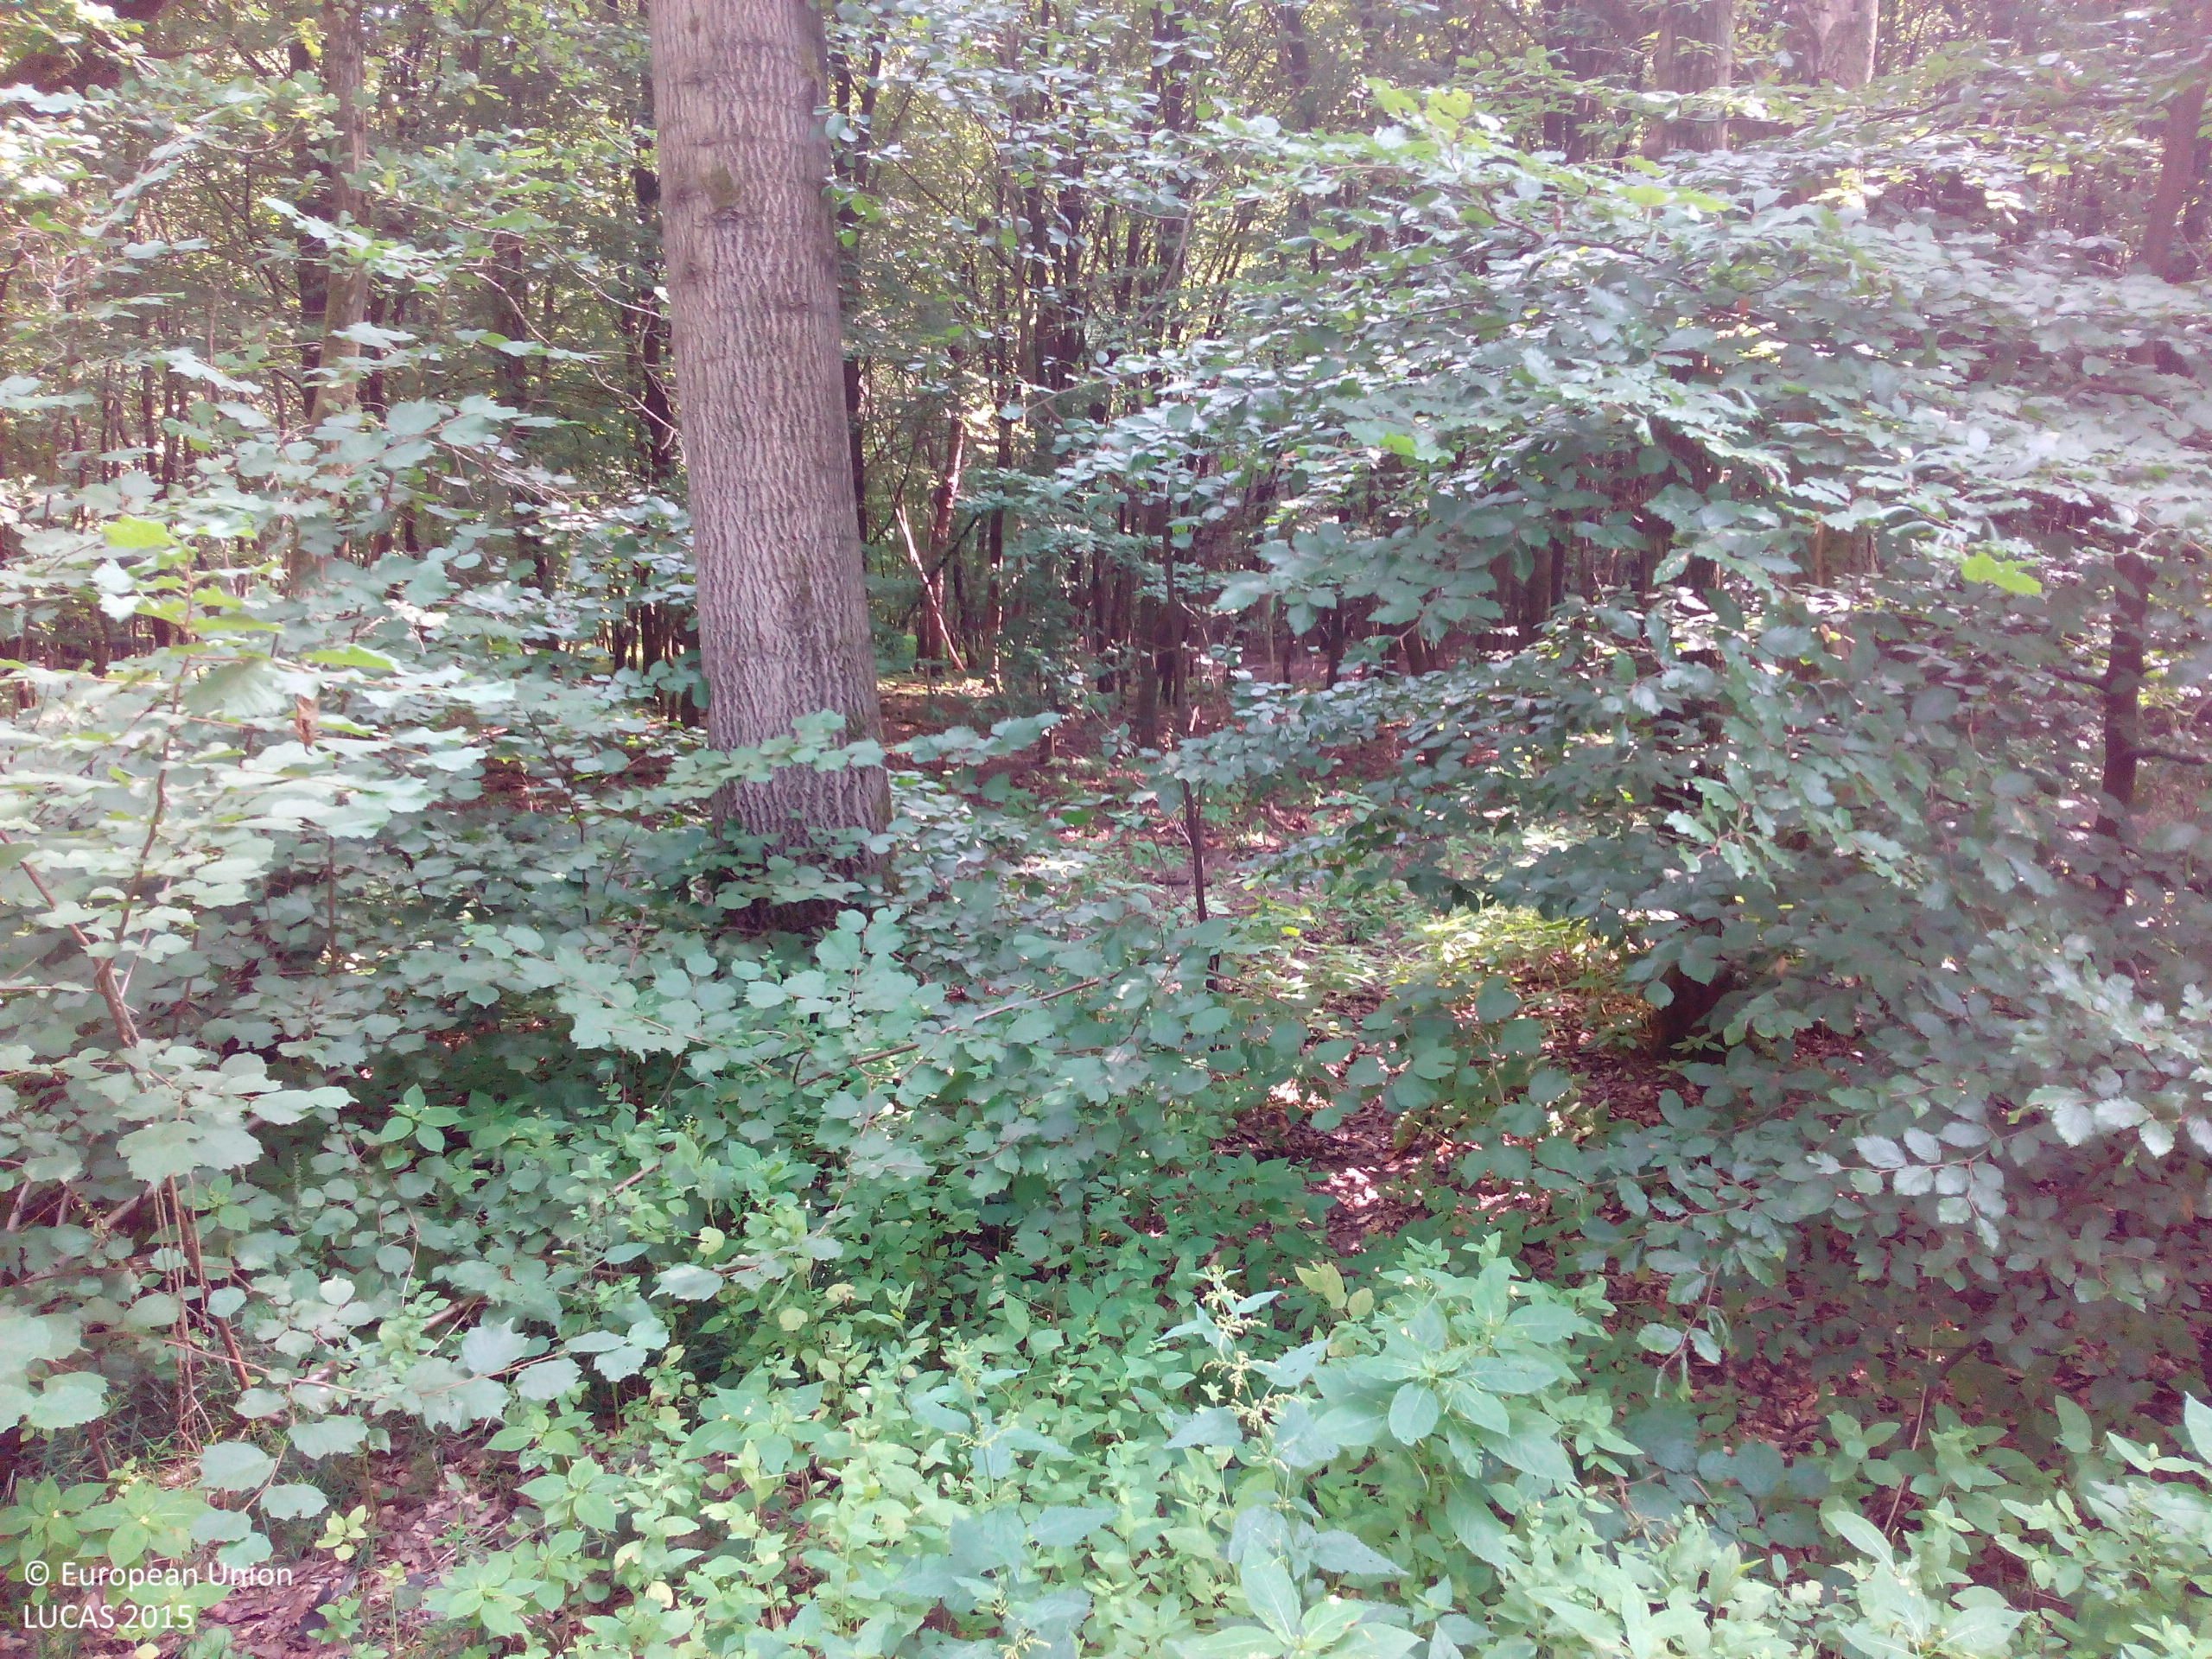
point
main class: Woodland
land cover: Broadleaved woodland
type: beech forest
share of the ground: > 75 %
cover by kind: broadleaved forest trees 100 %
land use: Forestry
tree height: > 5 m
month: August
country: DE
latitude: 53.0061
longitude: 10.3128
